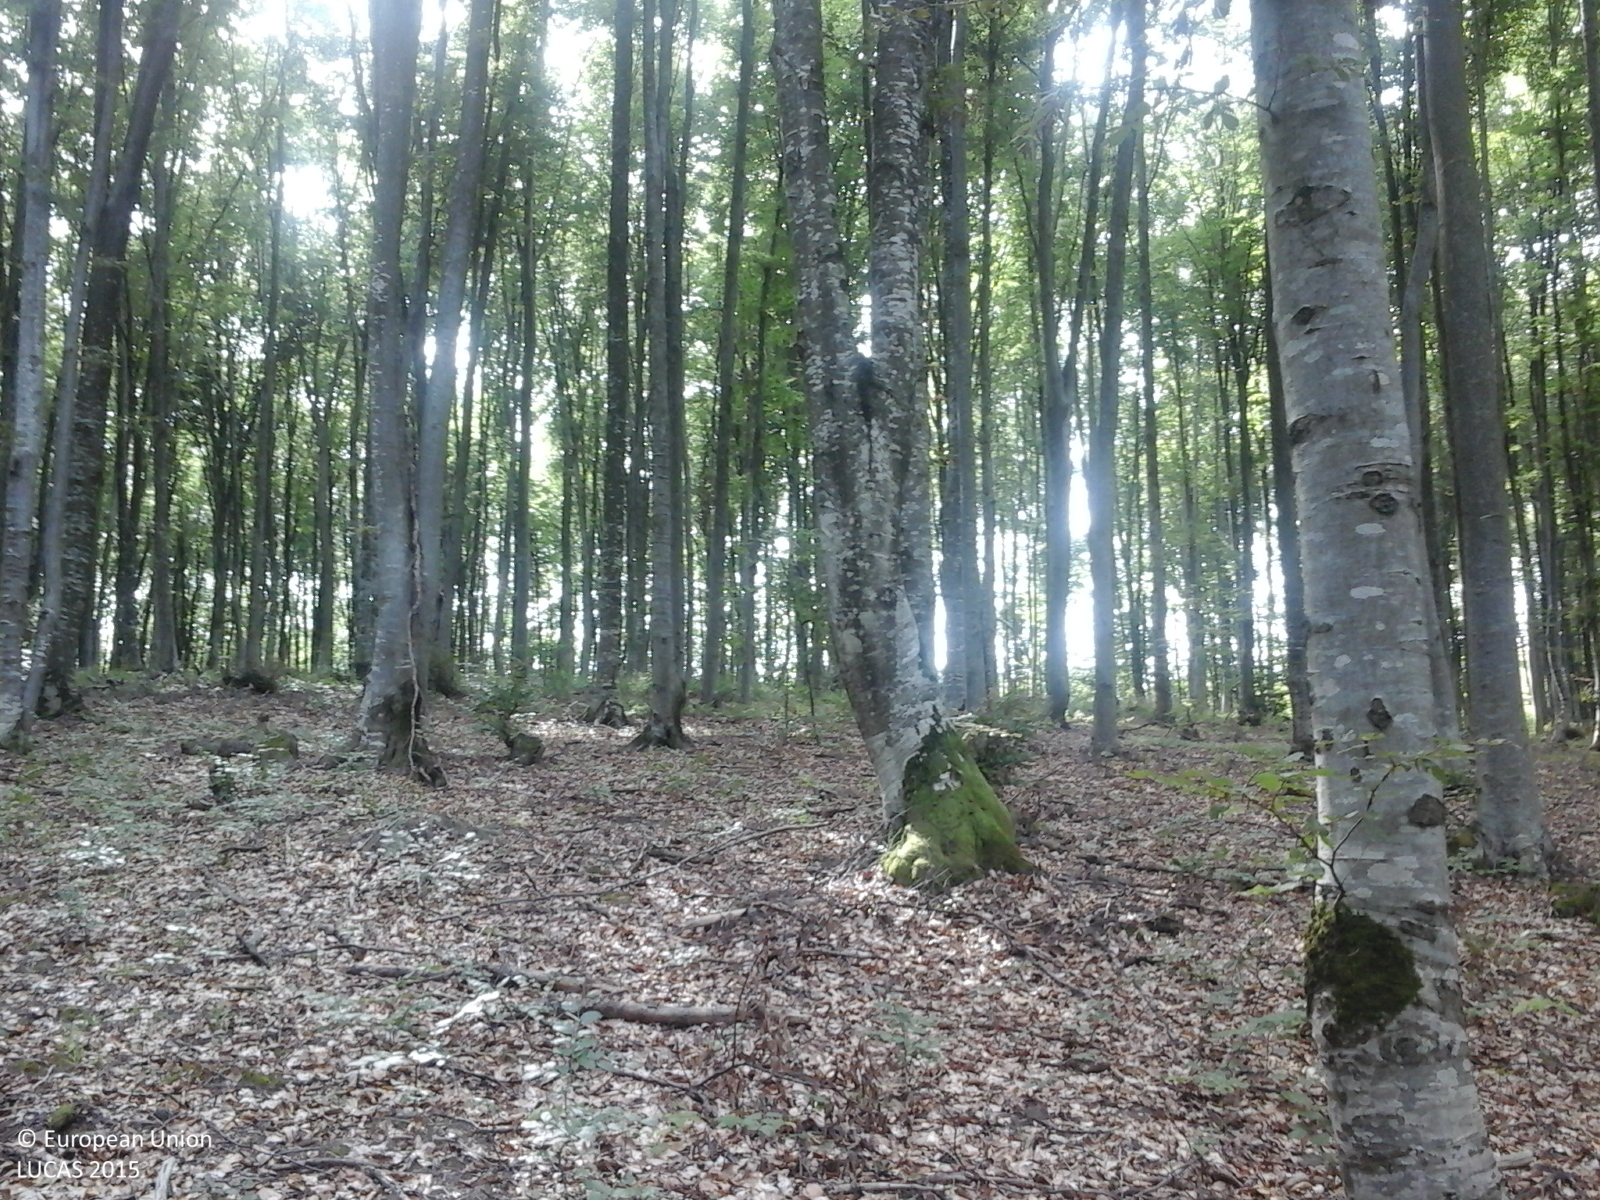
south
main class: Woodland
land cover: Broadleaved woodland
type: beech forest
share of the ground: > 75 %
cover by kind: broadleaved forest trees 100 %
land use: Forestry
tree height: > 5 m
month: September
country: RO
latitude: 47.2766
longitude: 23.9480
